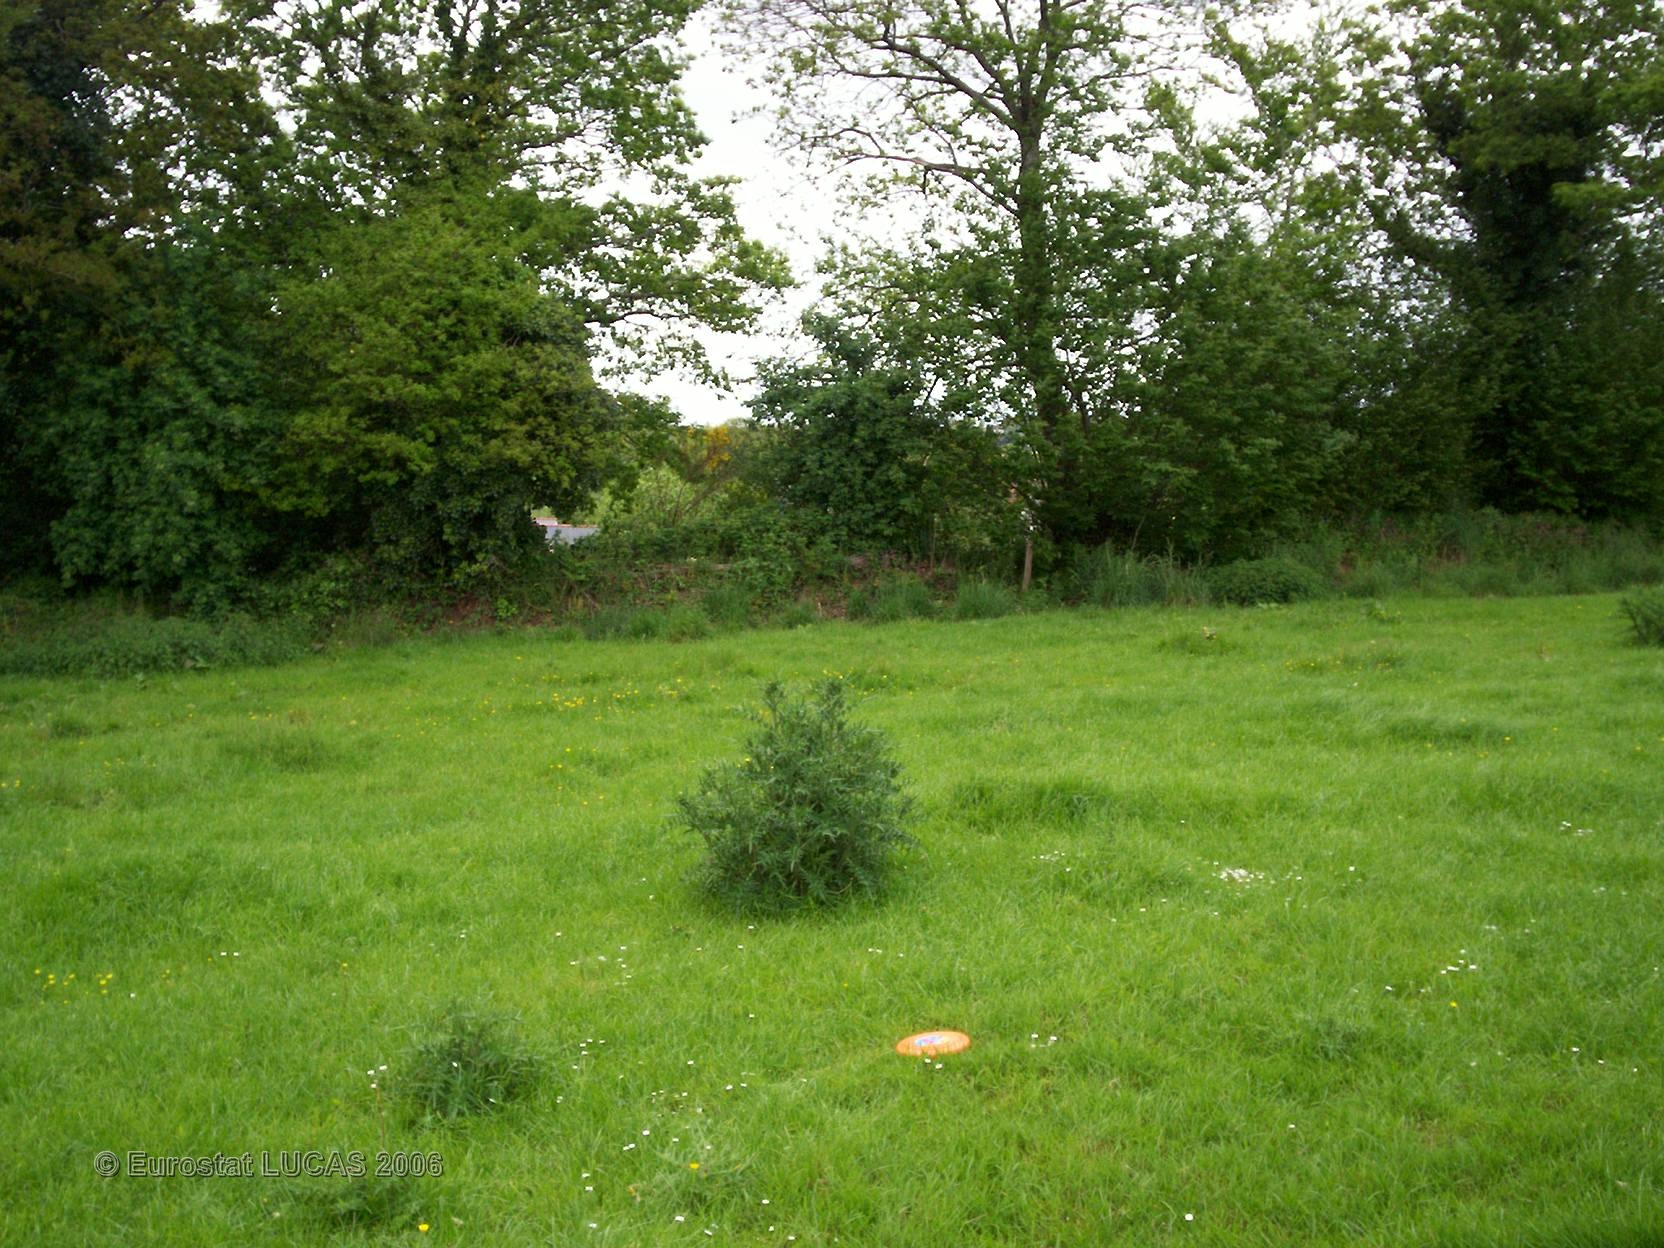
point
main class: Grassland
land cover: Grassland without tree/shrub cover
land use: Agriculture (excluding fallow land and kitchen gardens)
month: May
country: FR
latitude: 48.1039
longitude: -3.9038
